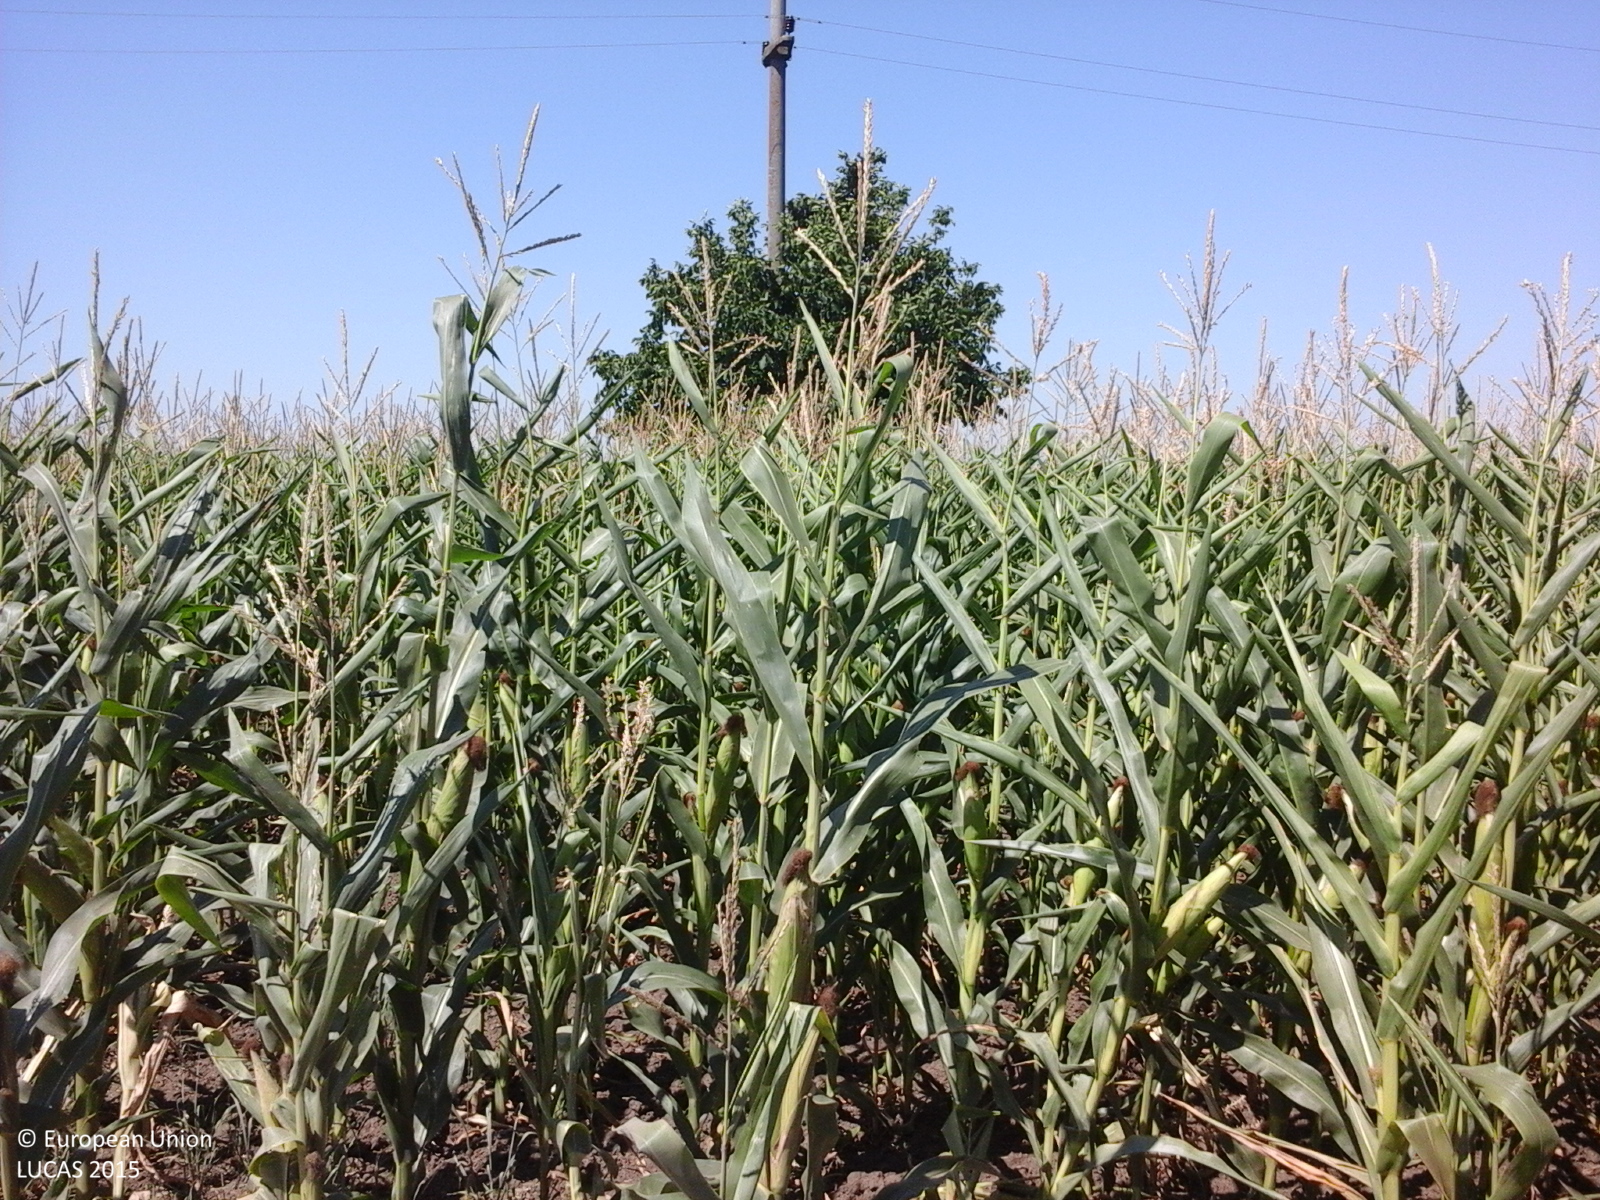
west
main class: Cropland
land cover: Maize
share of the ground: > 75 %
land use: Agriculture (excluding fallow land and kitchen gardens)
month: July
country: RO
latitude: 44.3439
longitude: 26.7147
